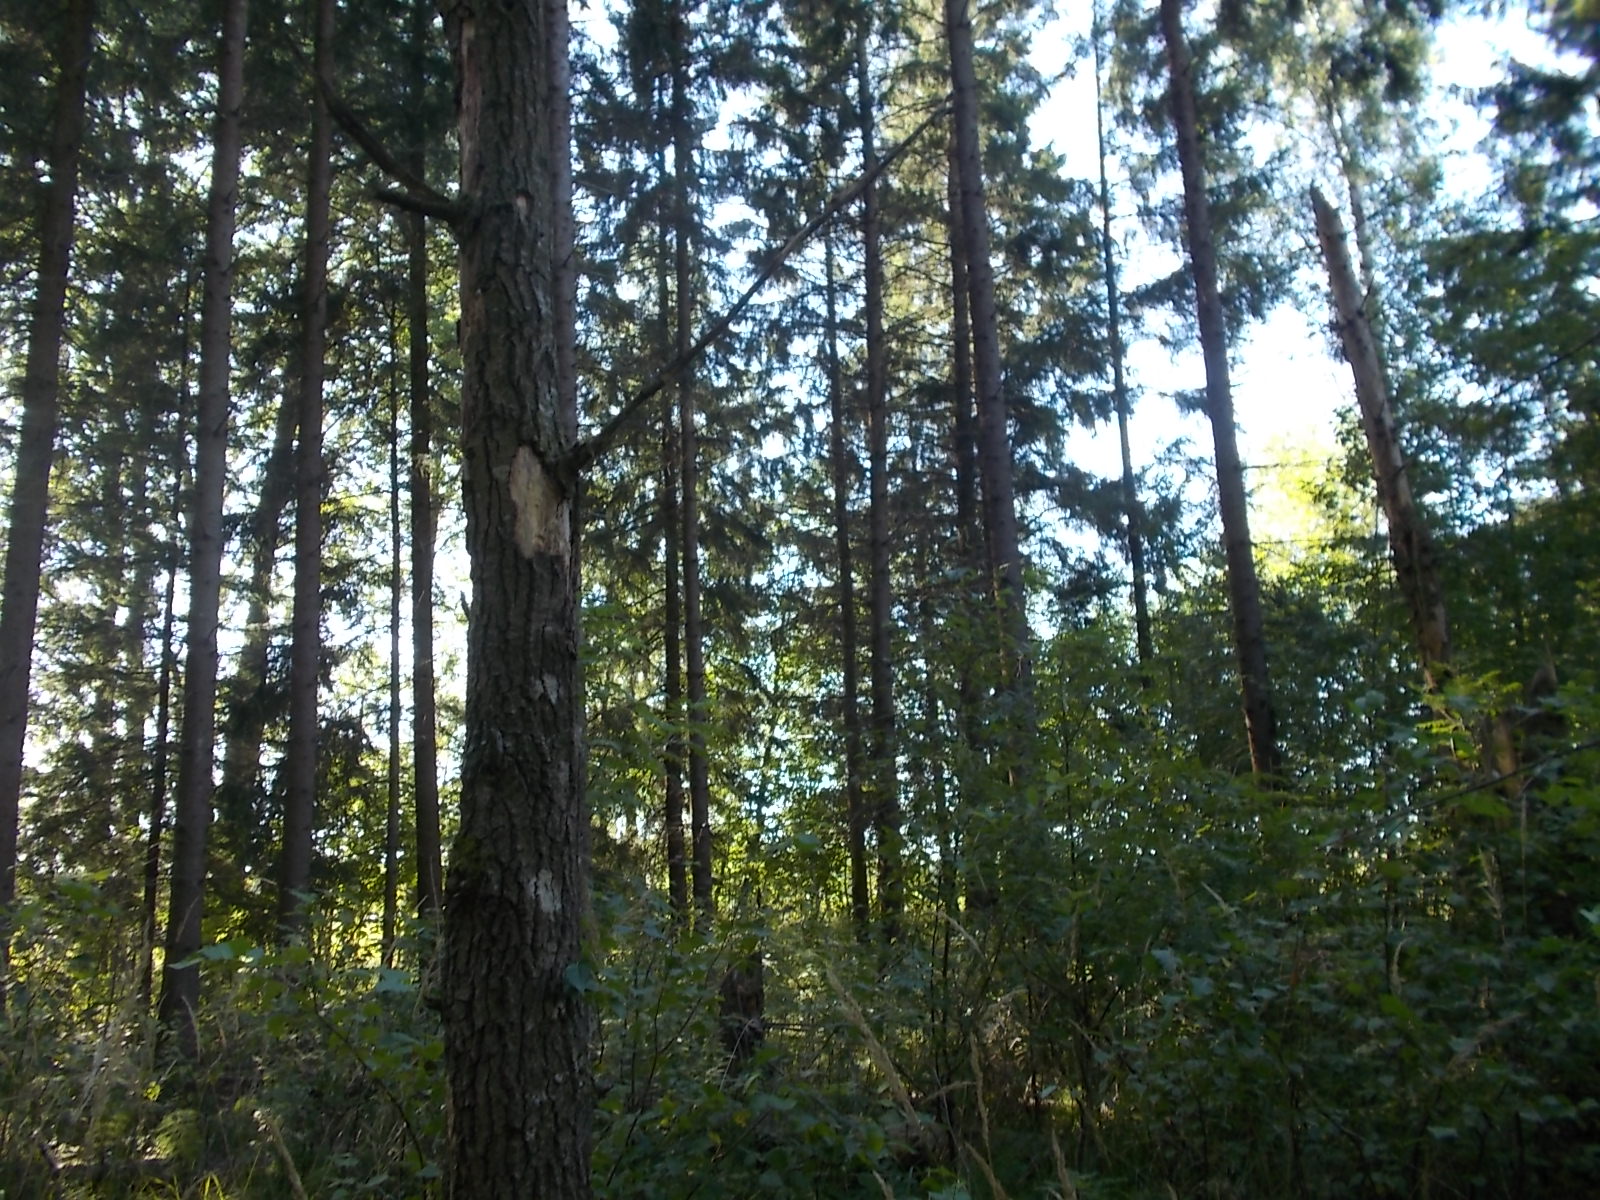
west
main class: Woodland
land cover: Spruce dominated coniferous woodland
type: hemiboreal forest and nemoral coniferous forest and mixed broadleaved-coniferous forest
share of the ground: > 75 %
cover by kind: coniferous forest trees 75 %, broadleaved forest trees 10 %, herbaceous plants 10 %, shrubs 5 %
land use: Forestry
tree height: > 5 m
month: August
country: LV
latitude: 56.8463
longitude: 22.8999
